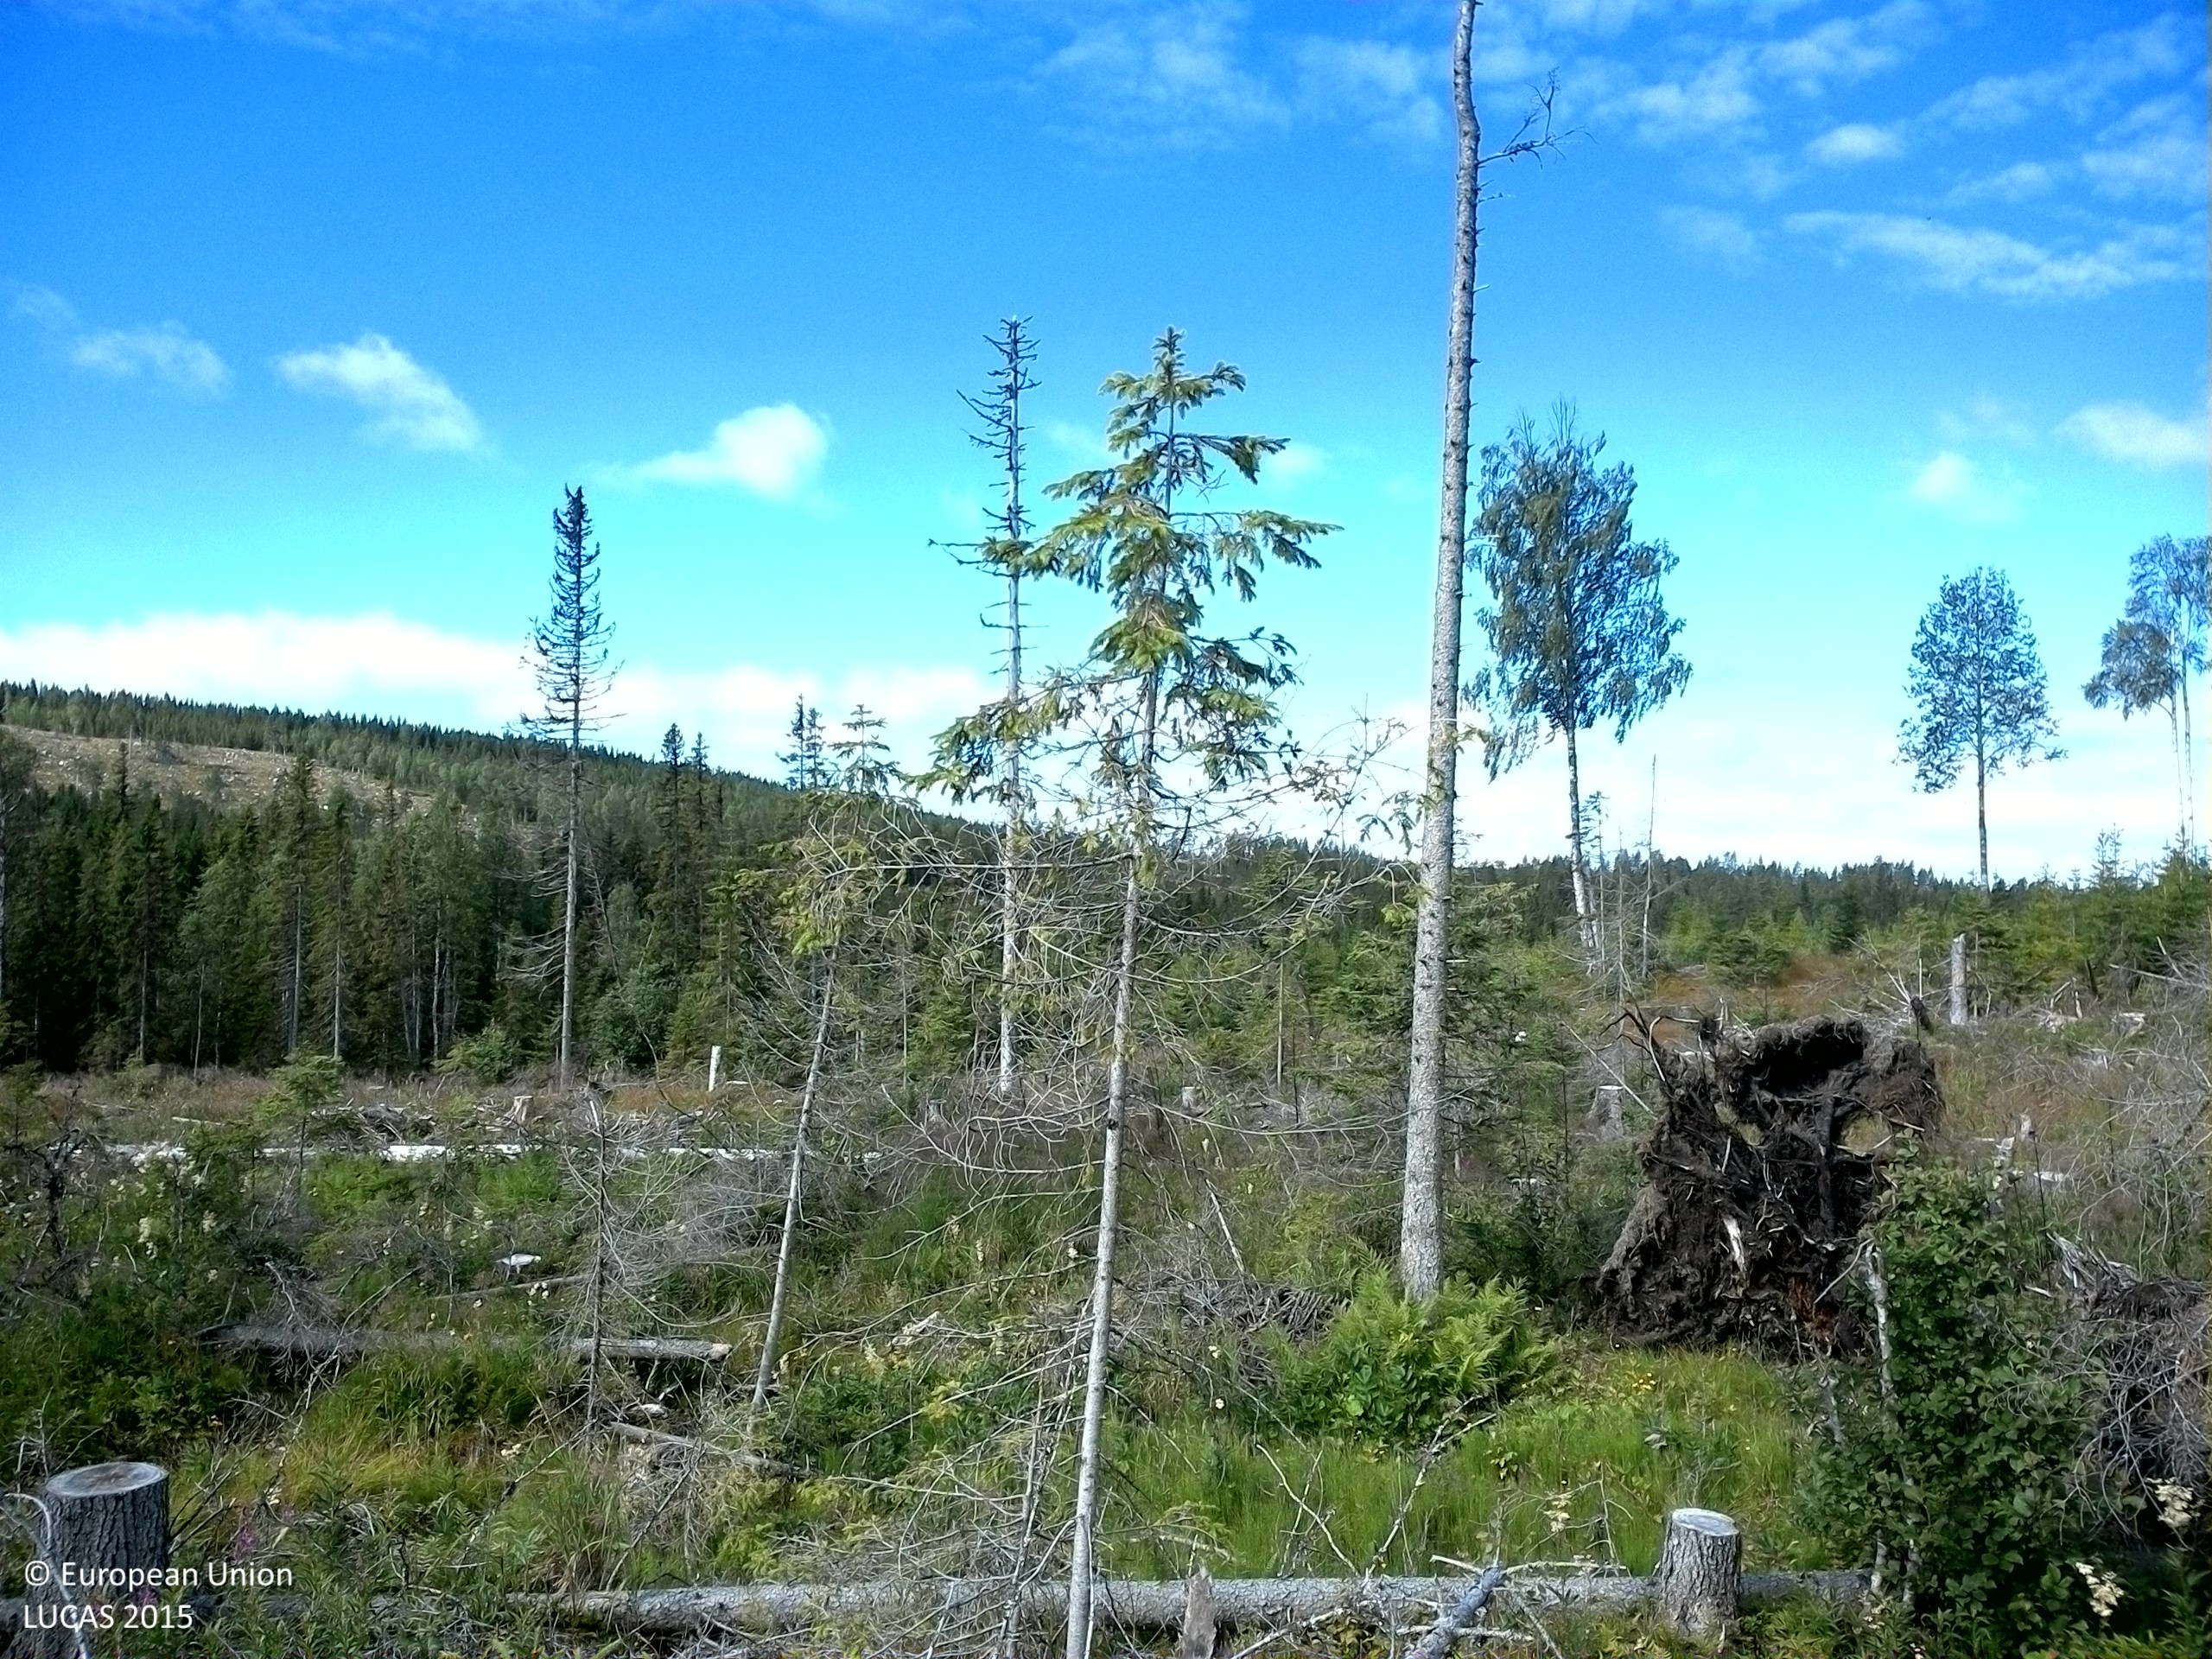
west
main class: Woodland
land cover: Spruce dominated mixed woodland
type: boreal forest
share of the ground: 10 - 25 %
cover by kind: shrubs 45 %, herbaceous plants 25 %, coniferous forest trees 10 %, lichens and mosses 10 %, broadleaved forest trees 5 %, consolidated bare surface 5 %
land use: Forestry
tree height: < 5 m
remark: Clear cut
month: August
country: SE
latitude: 62.8496
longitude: 16.5577
